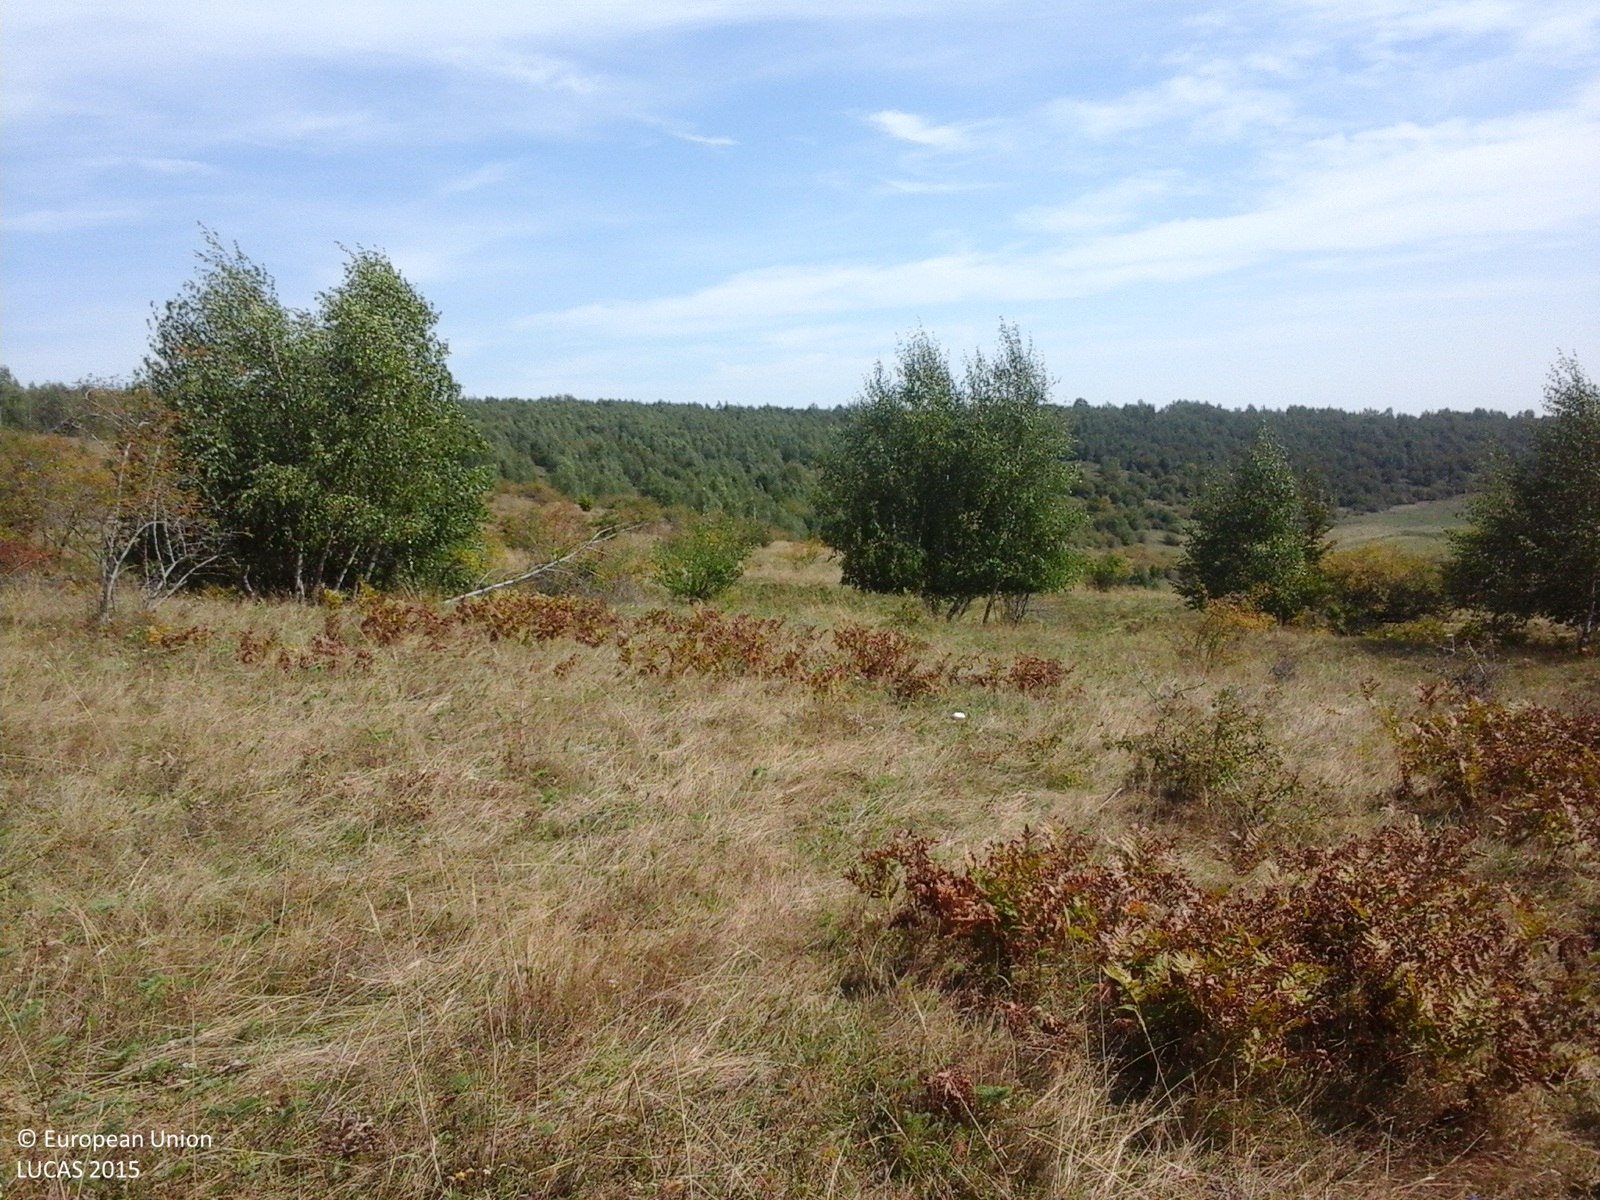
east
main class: Grassland
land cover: Grassland with sparse tree/shrub cover
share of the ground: > 75 %
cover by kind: herbaceous plants 85 %, shrubs 10 %, broadleaved forest trees 5 %
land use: Agriculture (excluding fallow land and kitchen gardens)
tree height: > 5 m
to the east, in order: Grassland with sparse tree/shrub cover
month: September
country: RO
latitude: 46.6501
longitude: 23.5673
